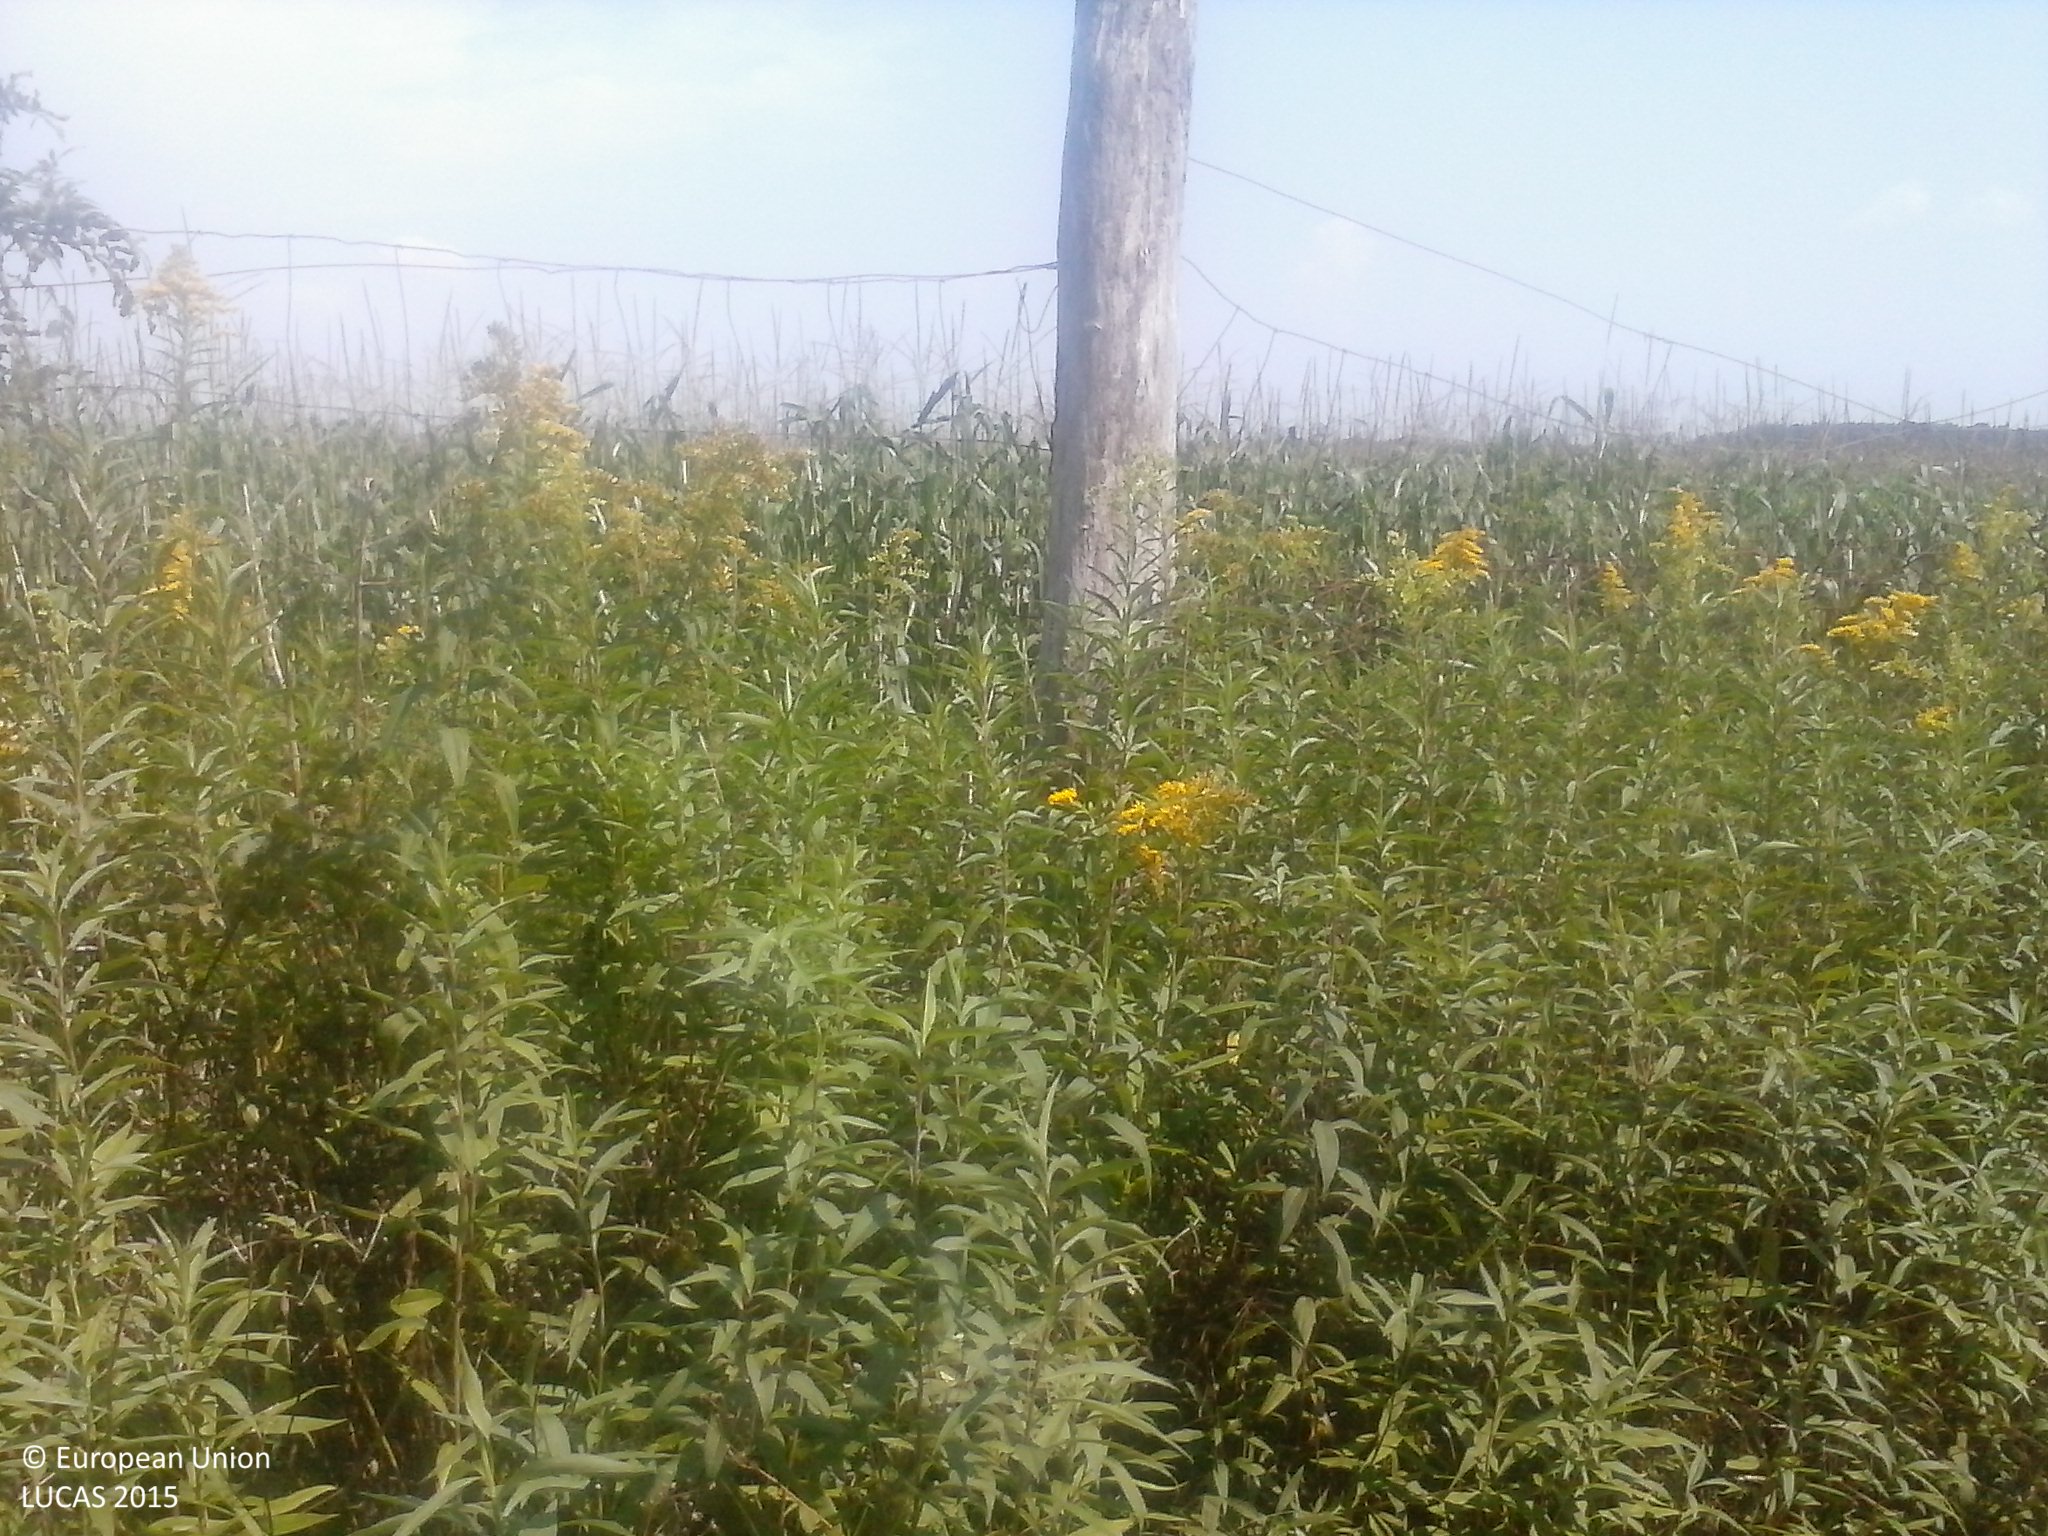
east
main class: Cropland
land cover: Maize
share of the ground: > 75 %
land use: Agriculture (excluding fallow land and kitchen gardens)
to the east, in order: Maize
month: August
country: HU
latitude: 45.9247
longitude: 17.7540
